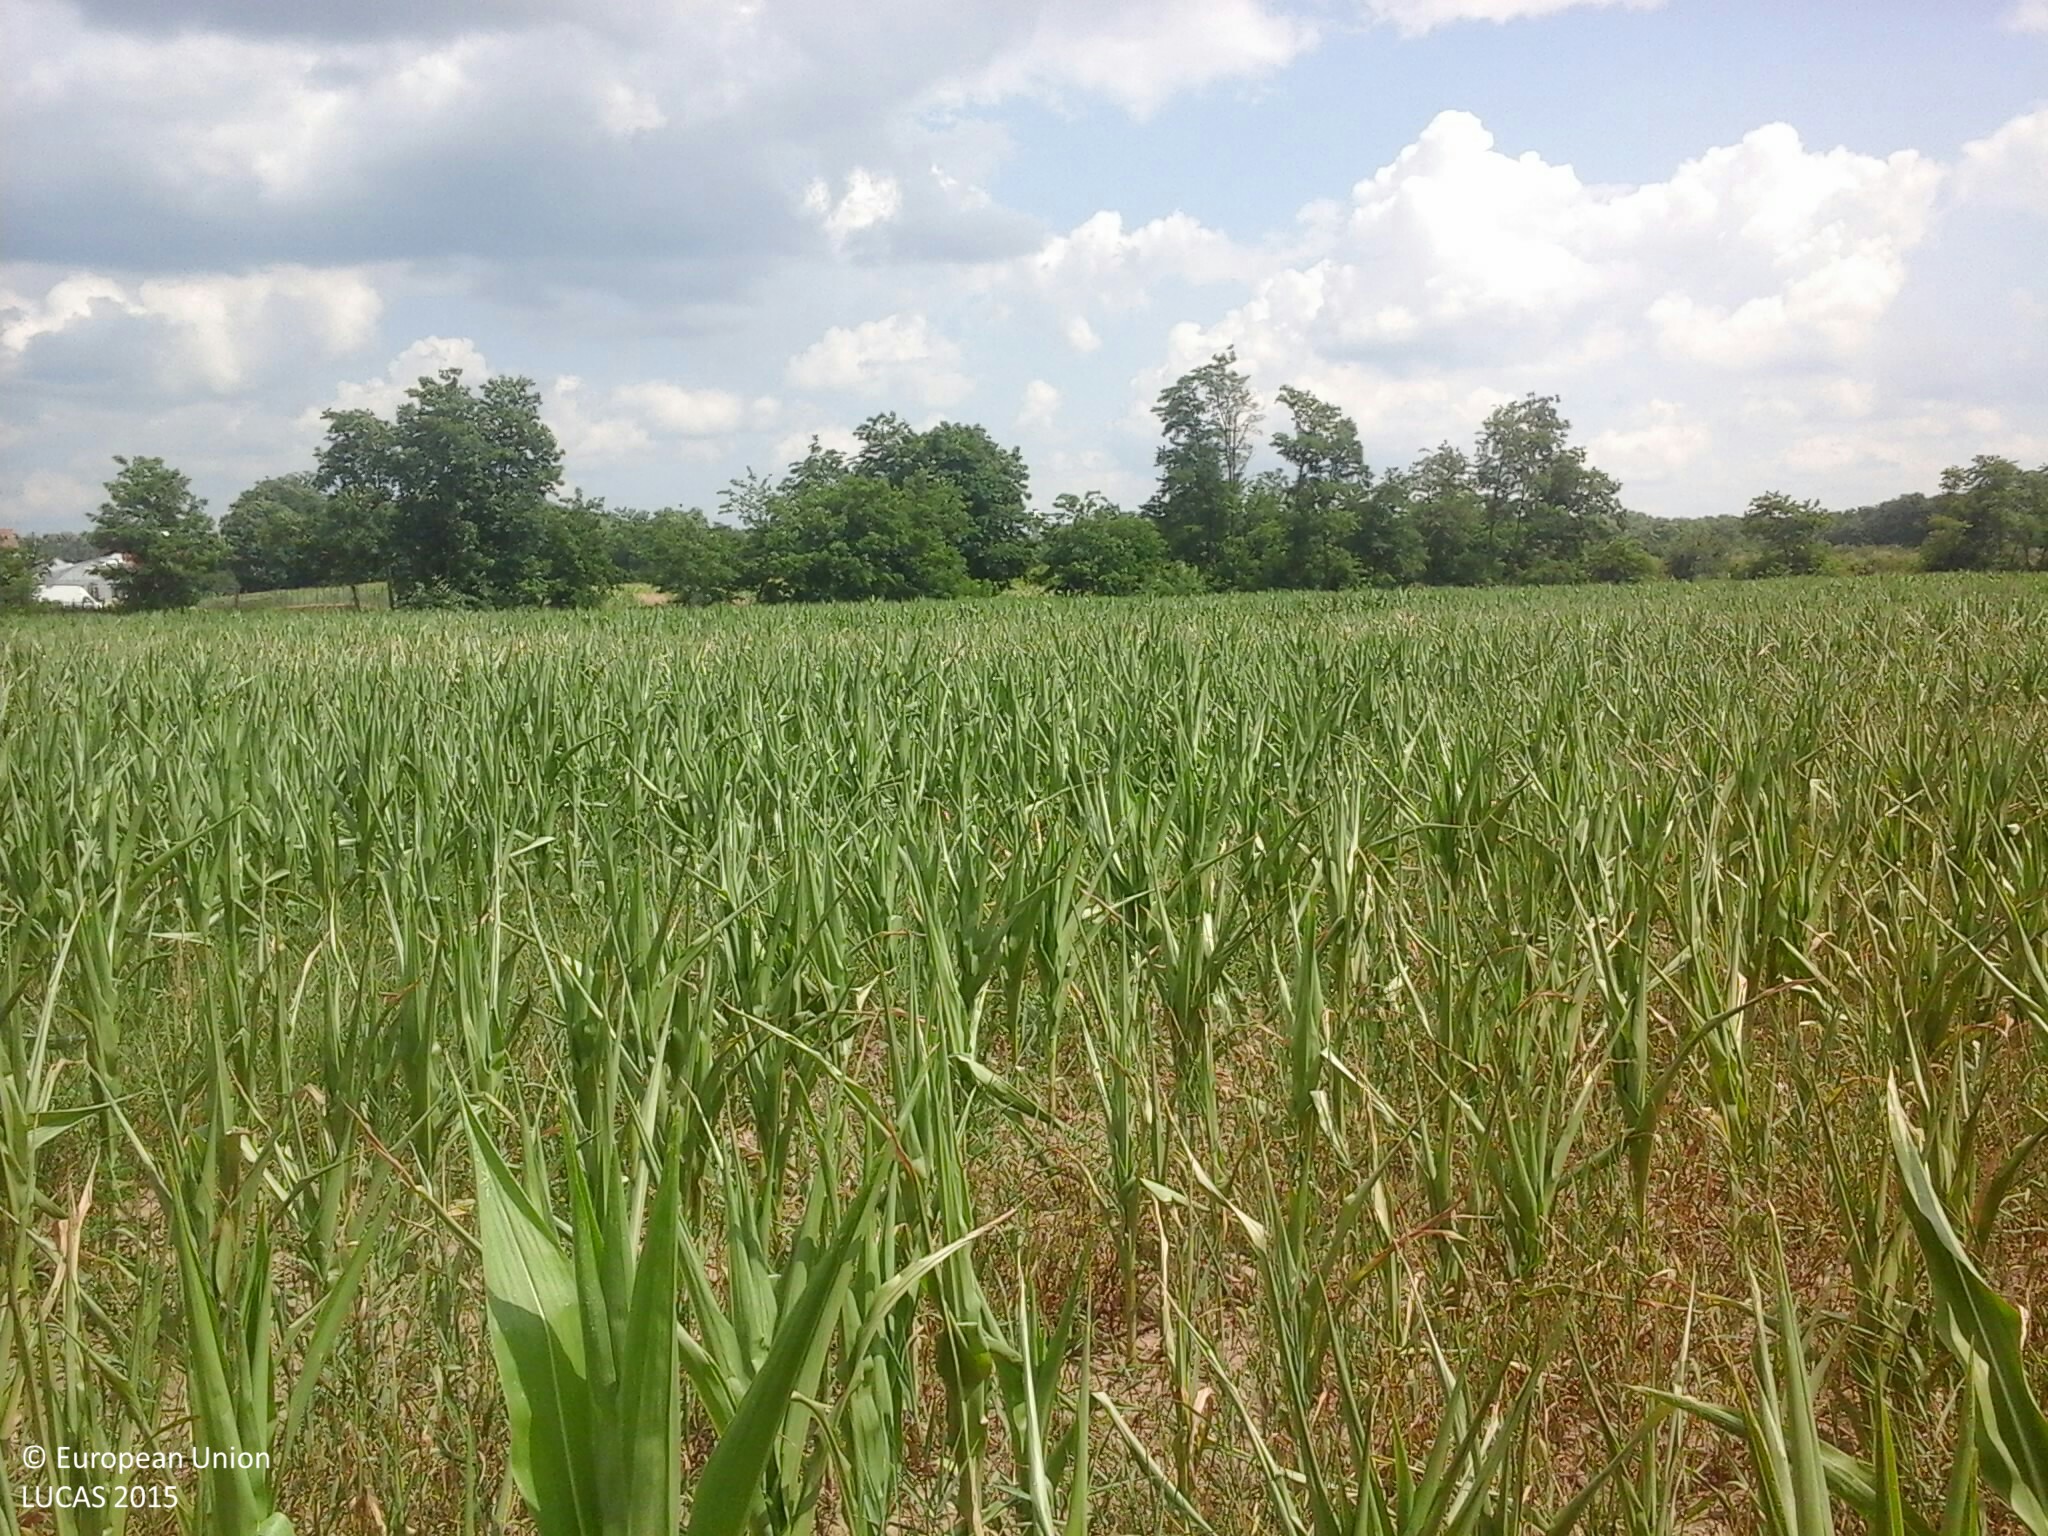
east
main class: Cropland
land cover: Maize
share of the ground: 25 - 50 %
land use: Agriculture (excluding fallow land and kitchen gardens)
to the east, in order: Maize; Spontaneously vegetated surfaces; Lines of trees; Ditches and canals; Grass margins; Tracks; Maize; Triticale
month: July
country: HU
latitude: 47.8225
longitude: 22.1413
